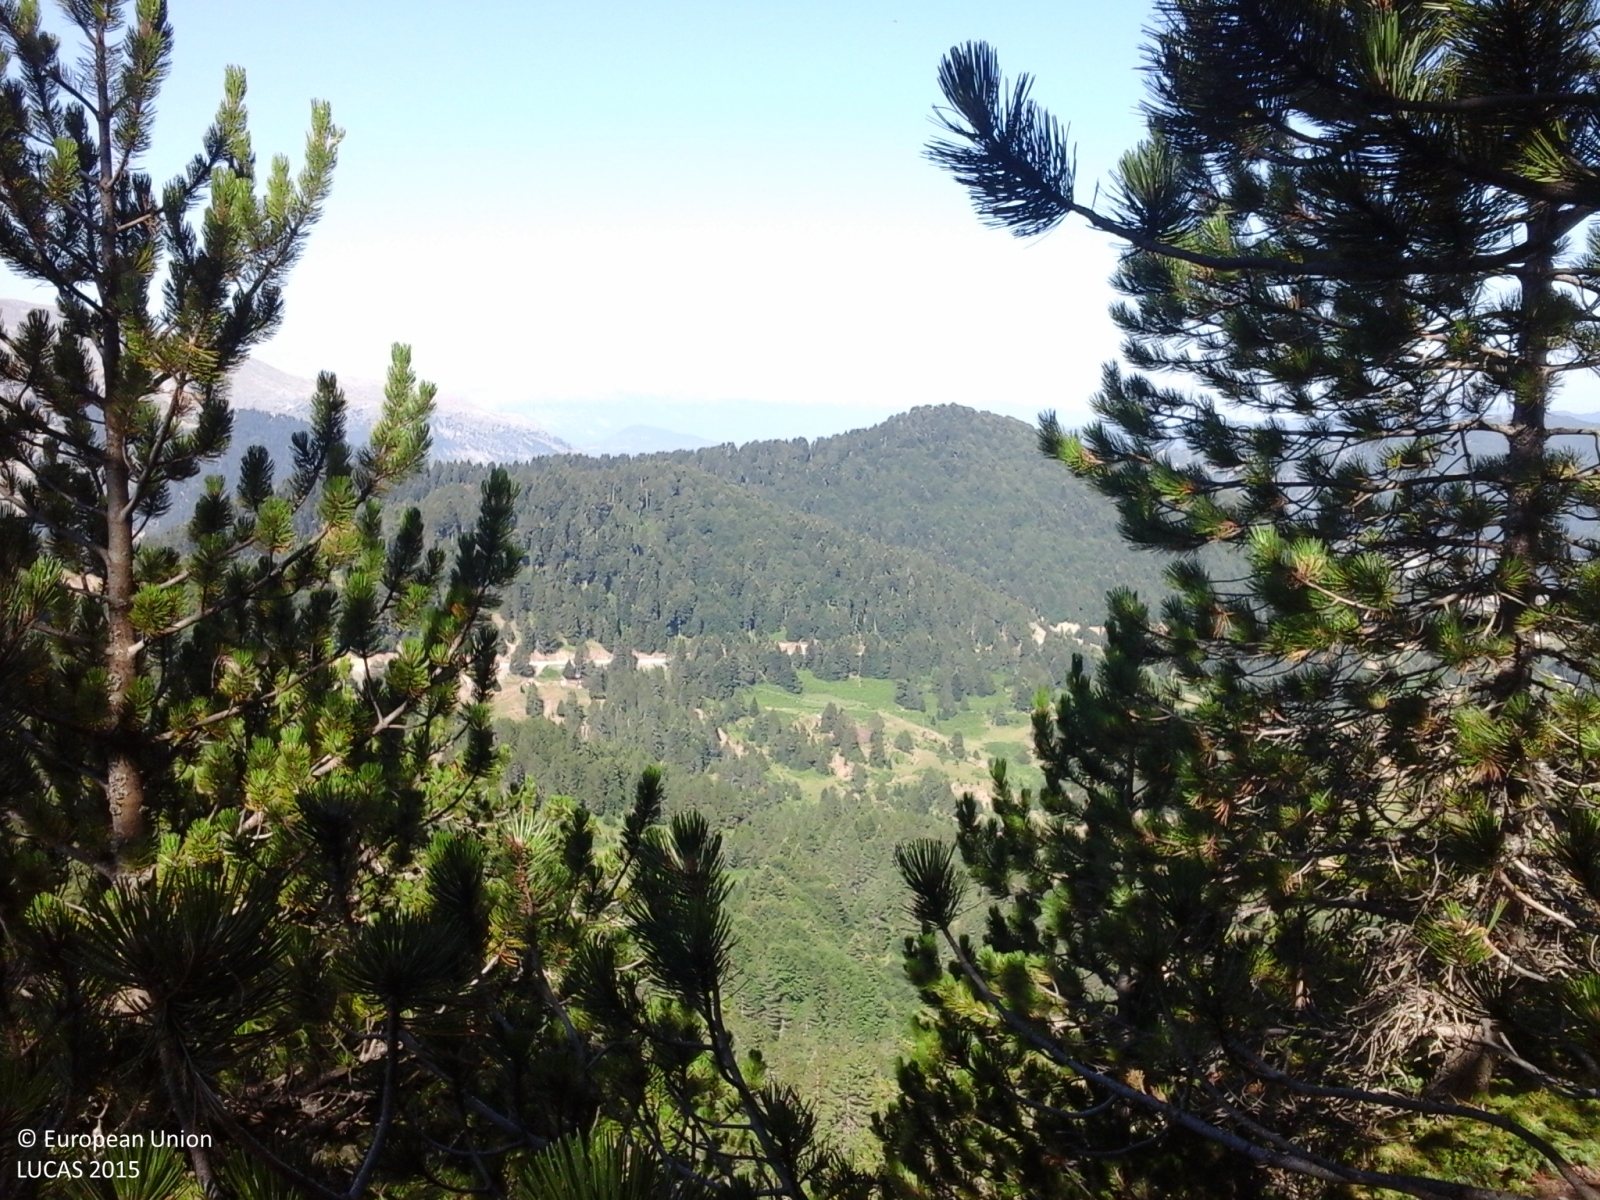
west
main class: Woodland
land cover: Pine dominated coniferous woodland
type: coniferous forest of the mediterranean region
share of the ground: 50 - 75 %
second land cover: Grassland without tree/shrub cover
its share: 10 - 25 %
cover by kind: coniferous forest trees 70 %, herbaceous plants 20 %, consolidated bare surface 10 %
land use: Forestry
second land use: Agriculture (excluding fallow land and kitchen gardens)
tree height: > 5 m
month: July
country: GR
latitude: 39.7493
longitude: 21.2205
